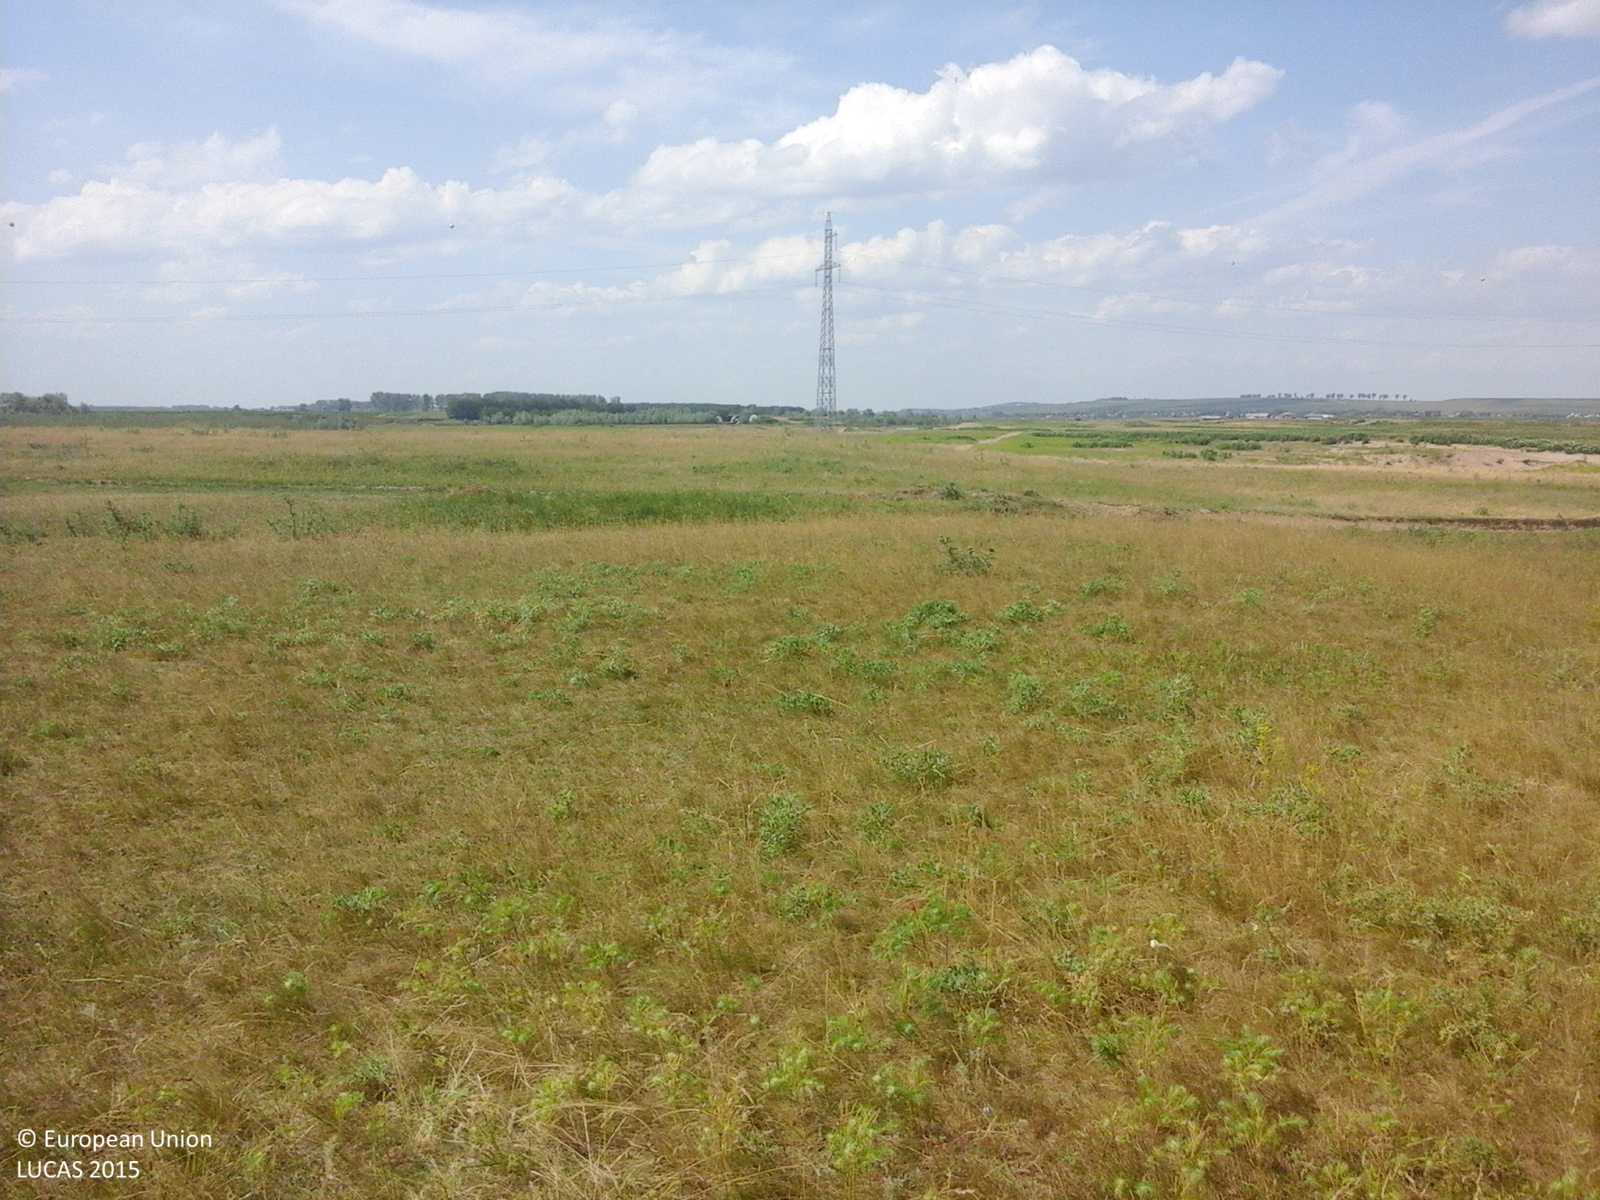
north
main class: Grassland
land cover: Grassland without tree/shrub cover
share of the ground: > 75 %
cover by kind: herbaceous plants 100 %
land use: Agriculture (excluding fallow land and kitchen gardens)
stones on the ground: < 10 %
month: June
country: RO
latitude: 47.6691
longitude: 26.4839
